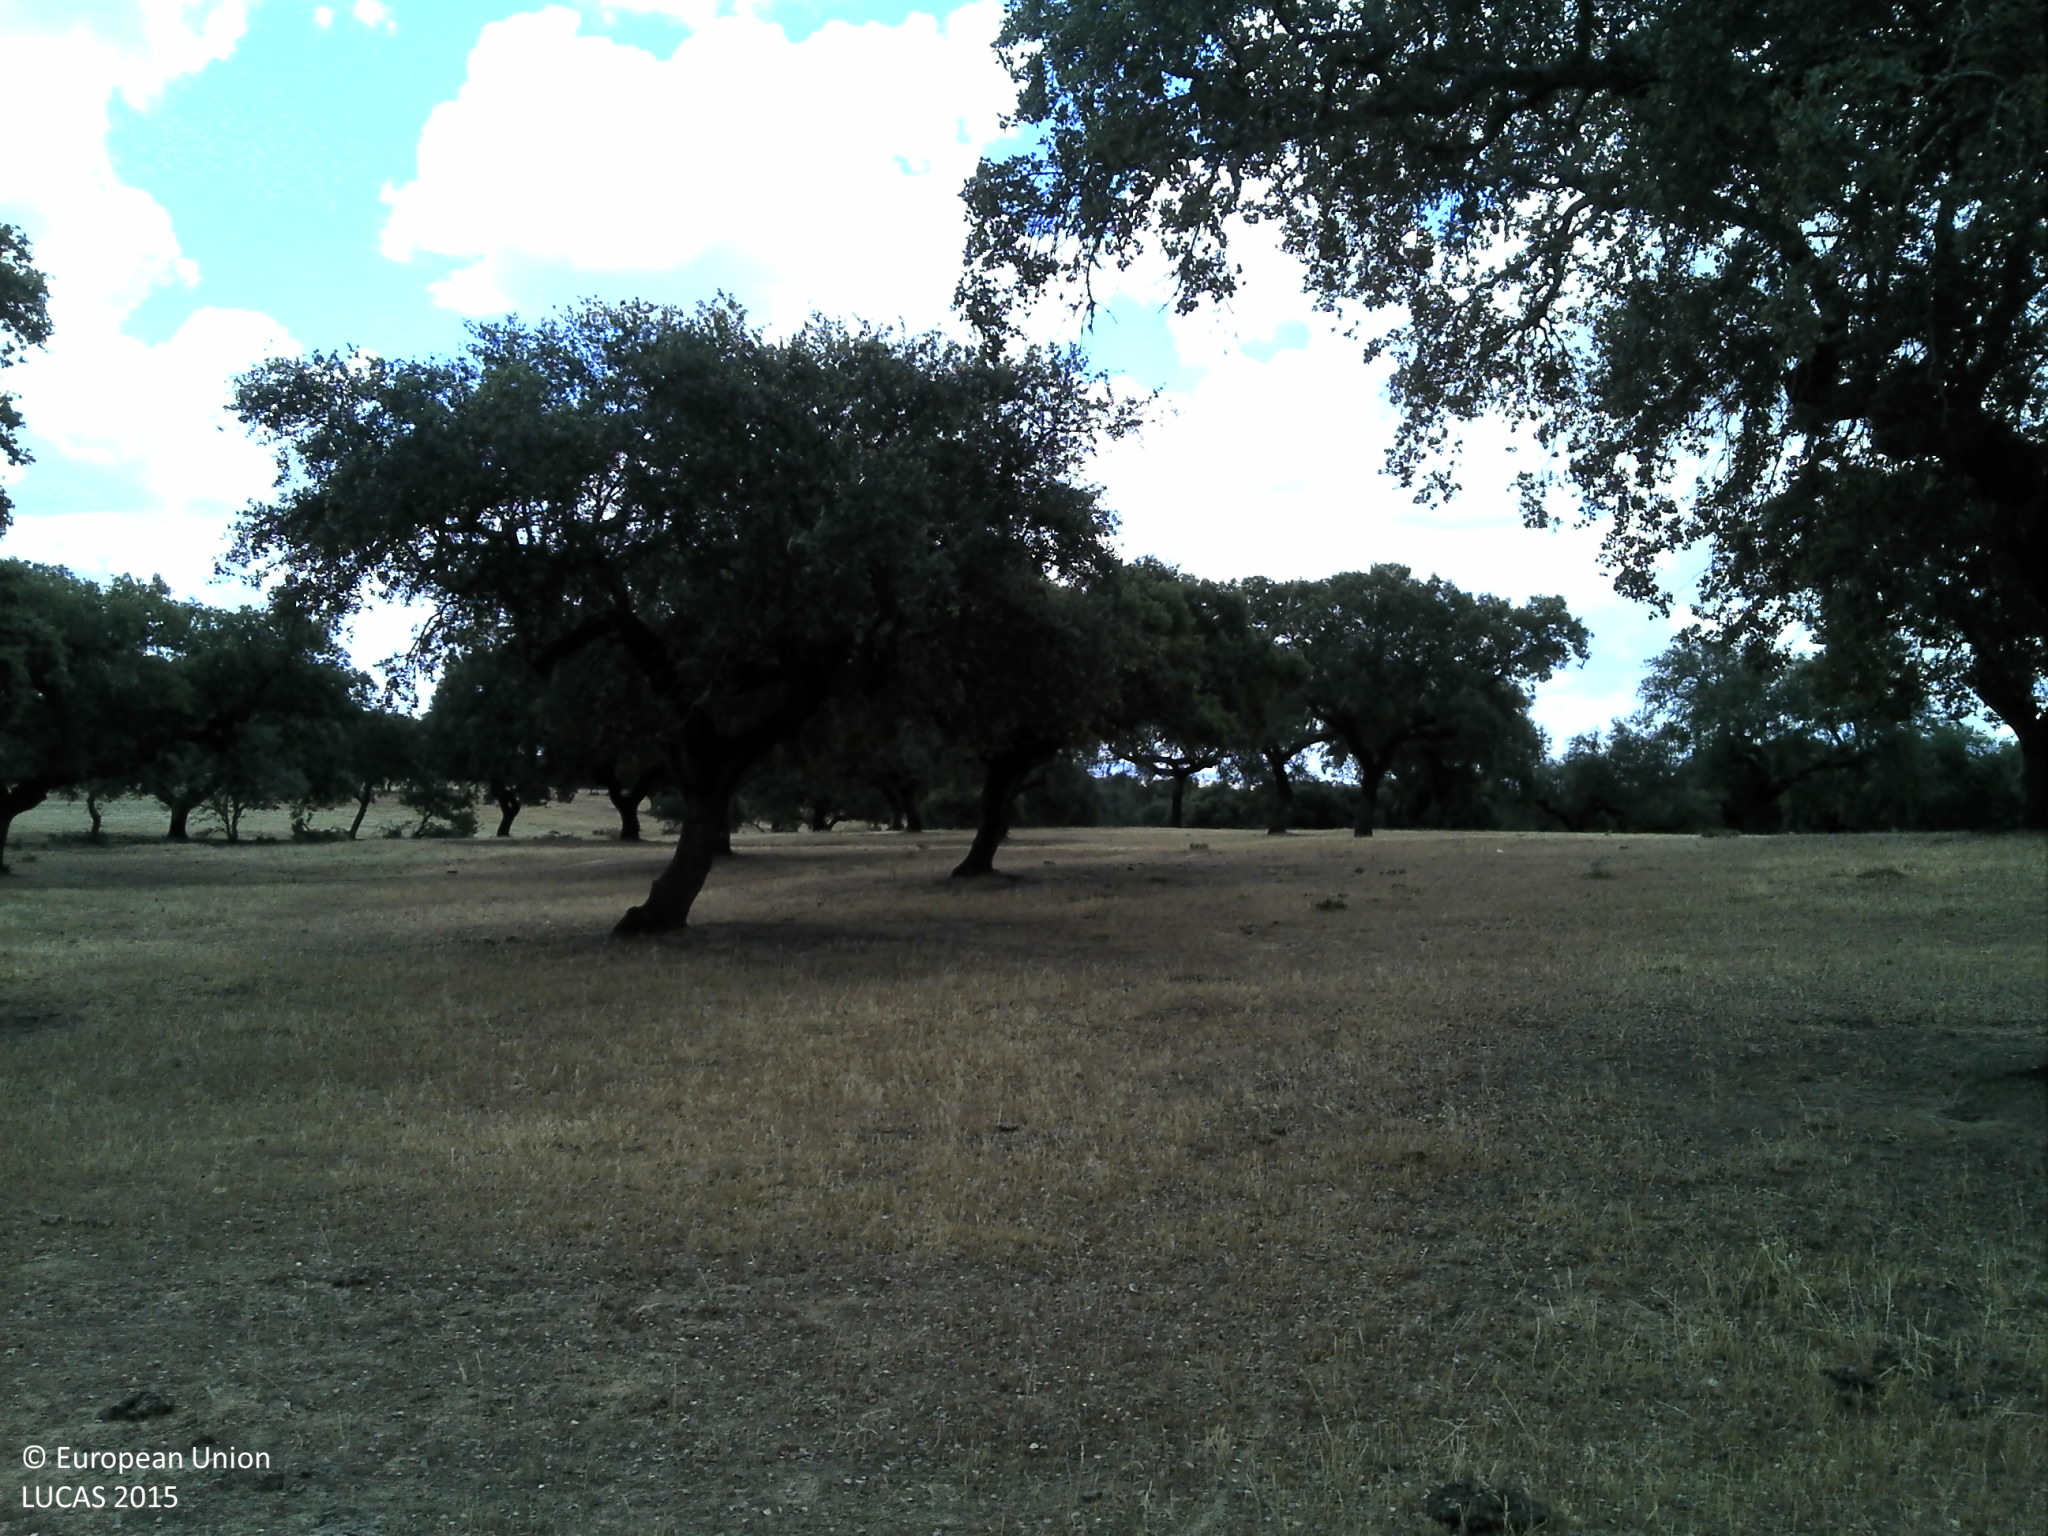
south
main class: Woodland
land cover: Broadleaved woodland
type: broadleaved evergreen forest
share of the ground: 10 - 25 %
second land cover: Grassland without tree/shrub cover
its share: 10 - 25 %
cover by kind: unconsolidated bare surface 70 %, broadleaved forest trees 15 %, herbaceous plants 15 %
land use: Forestry
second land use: Agriculture (excluding fallow land and kitchen gardens)
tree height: > 5 m
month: June
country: PT
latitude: 38.5199
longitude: -8.0609
